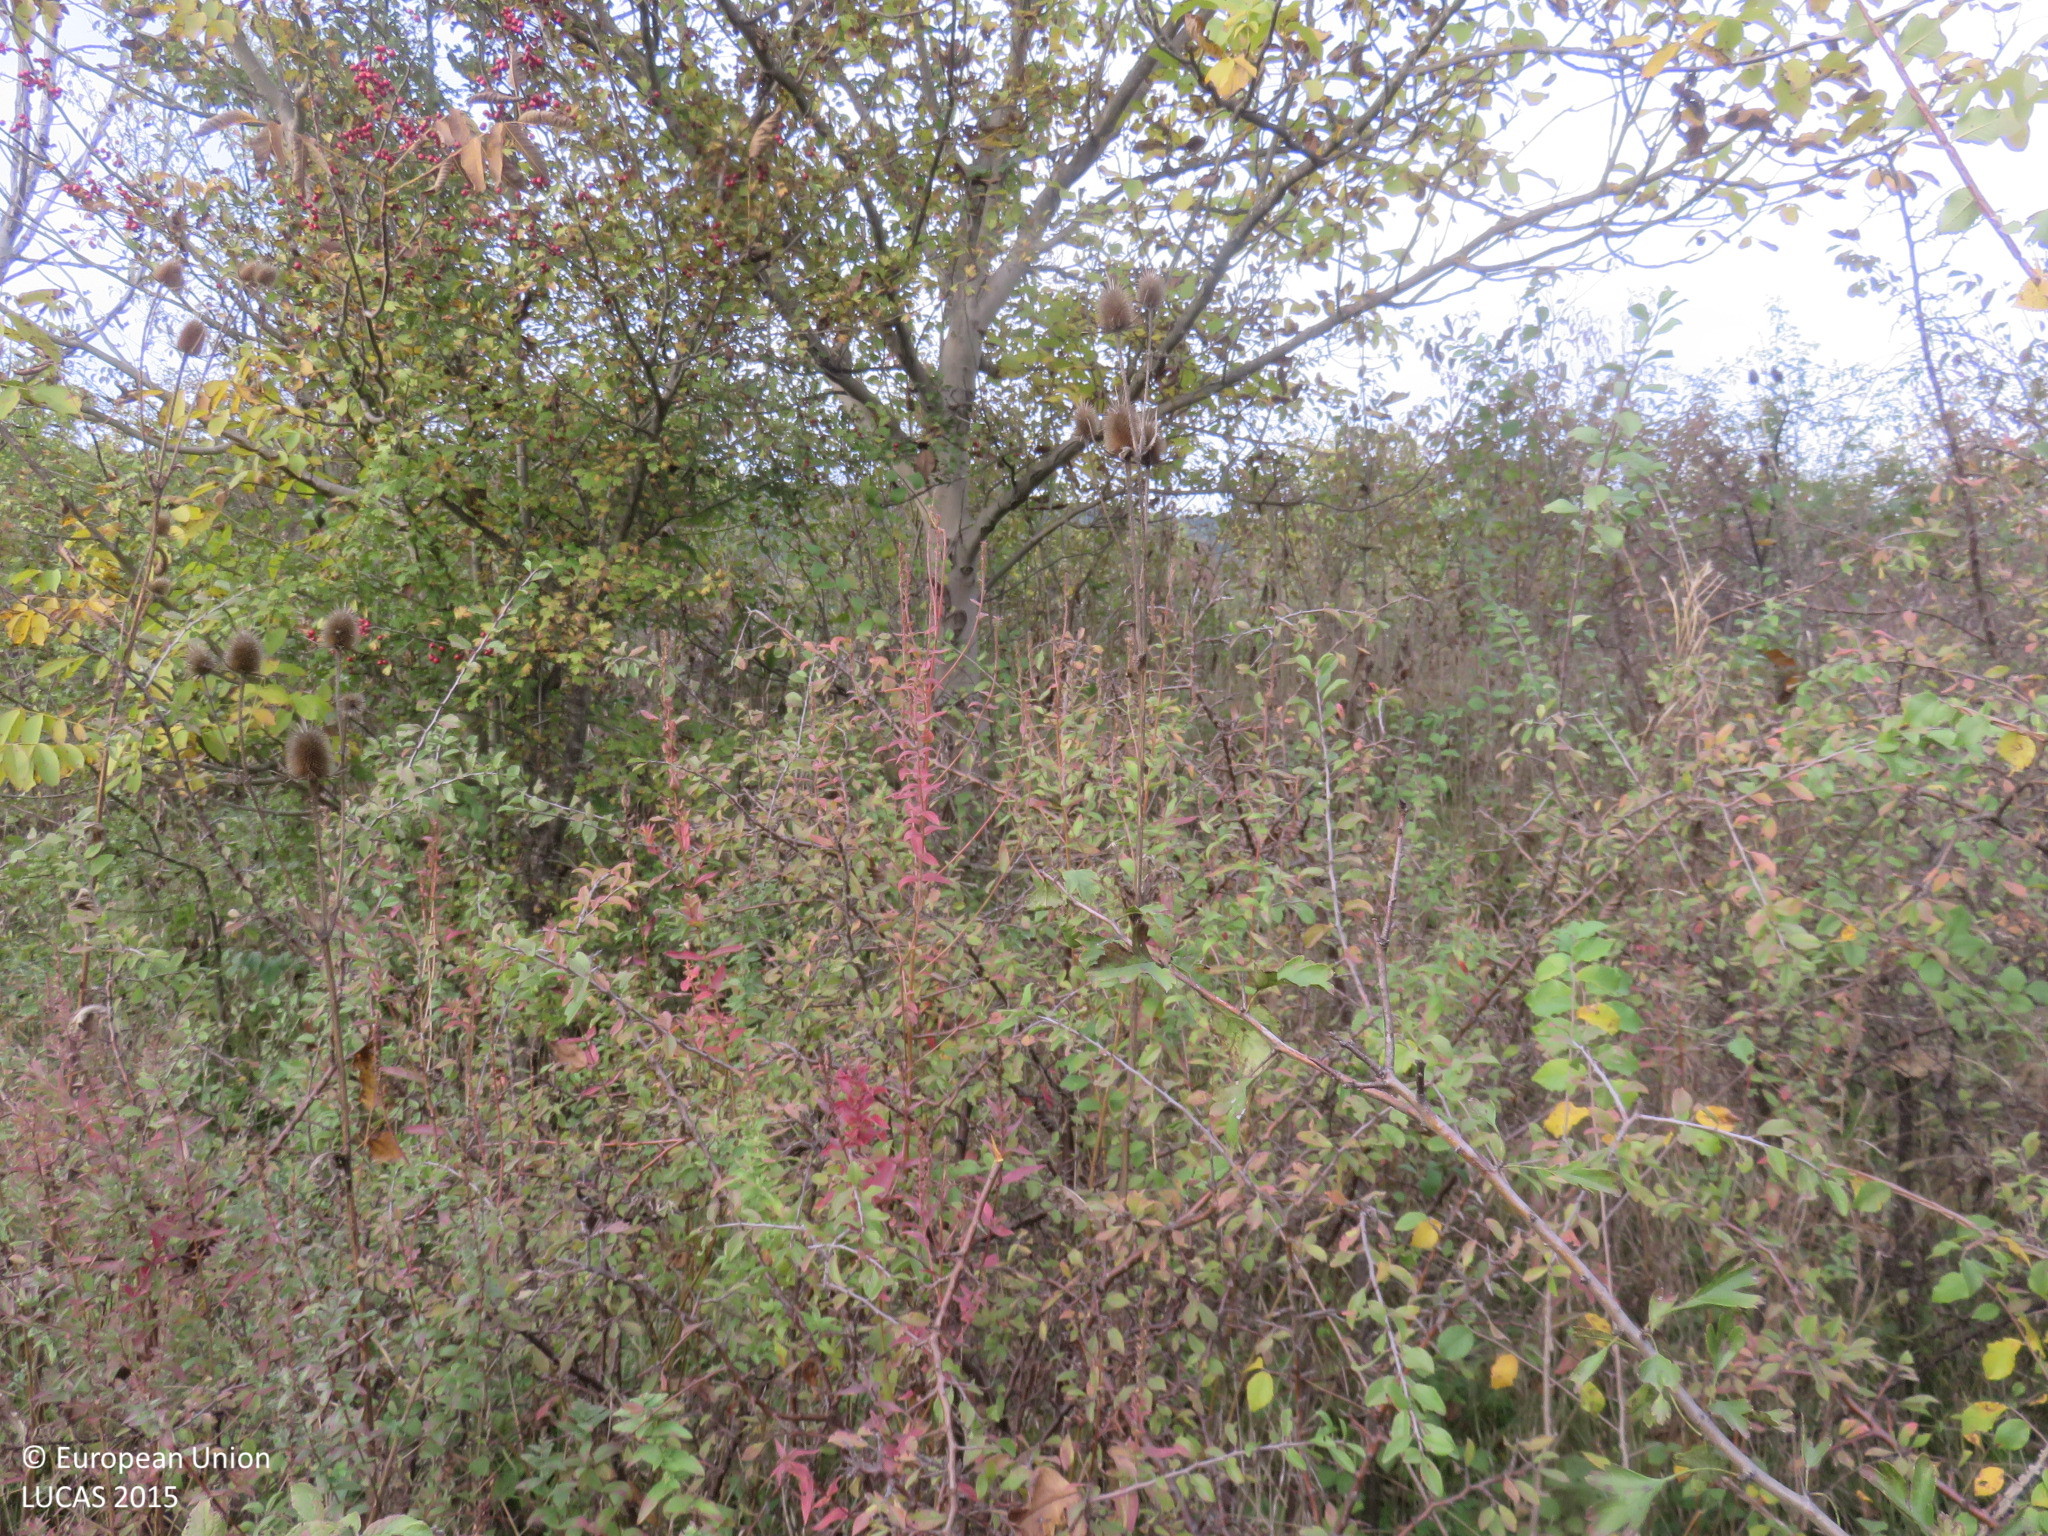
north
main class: Shrubland
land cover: Shrubland with sparse tree cover
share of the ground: > 75 %
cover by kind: shrubs 95 %, broadleaved forest trees 5 %
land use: Abandoned areas
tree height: < 5 m
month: October
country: BG
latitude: 43.1235
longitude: 25.2521
